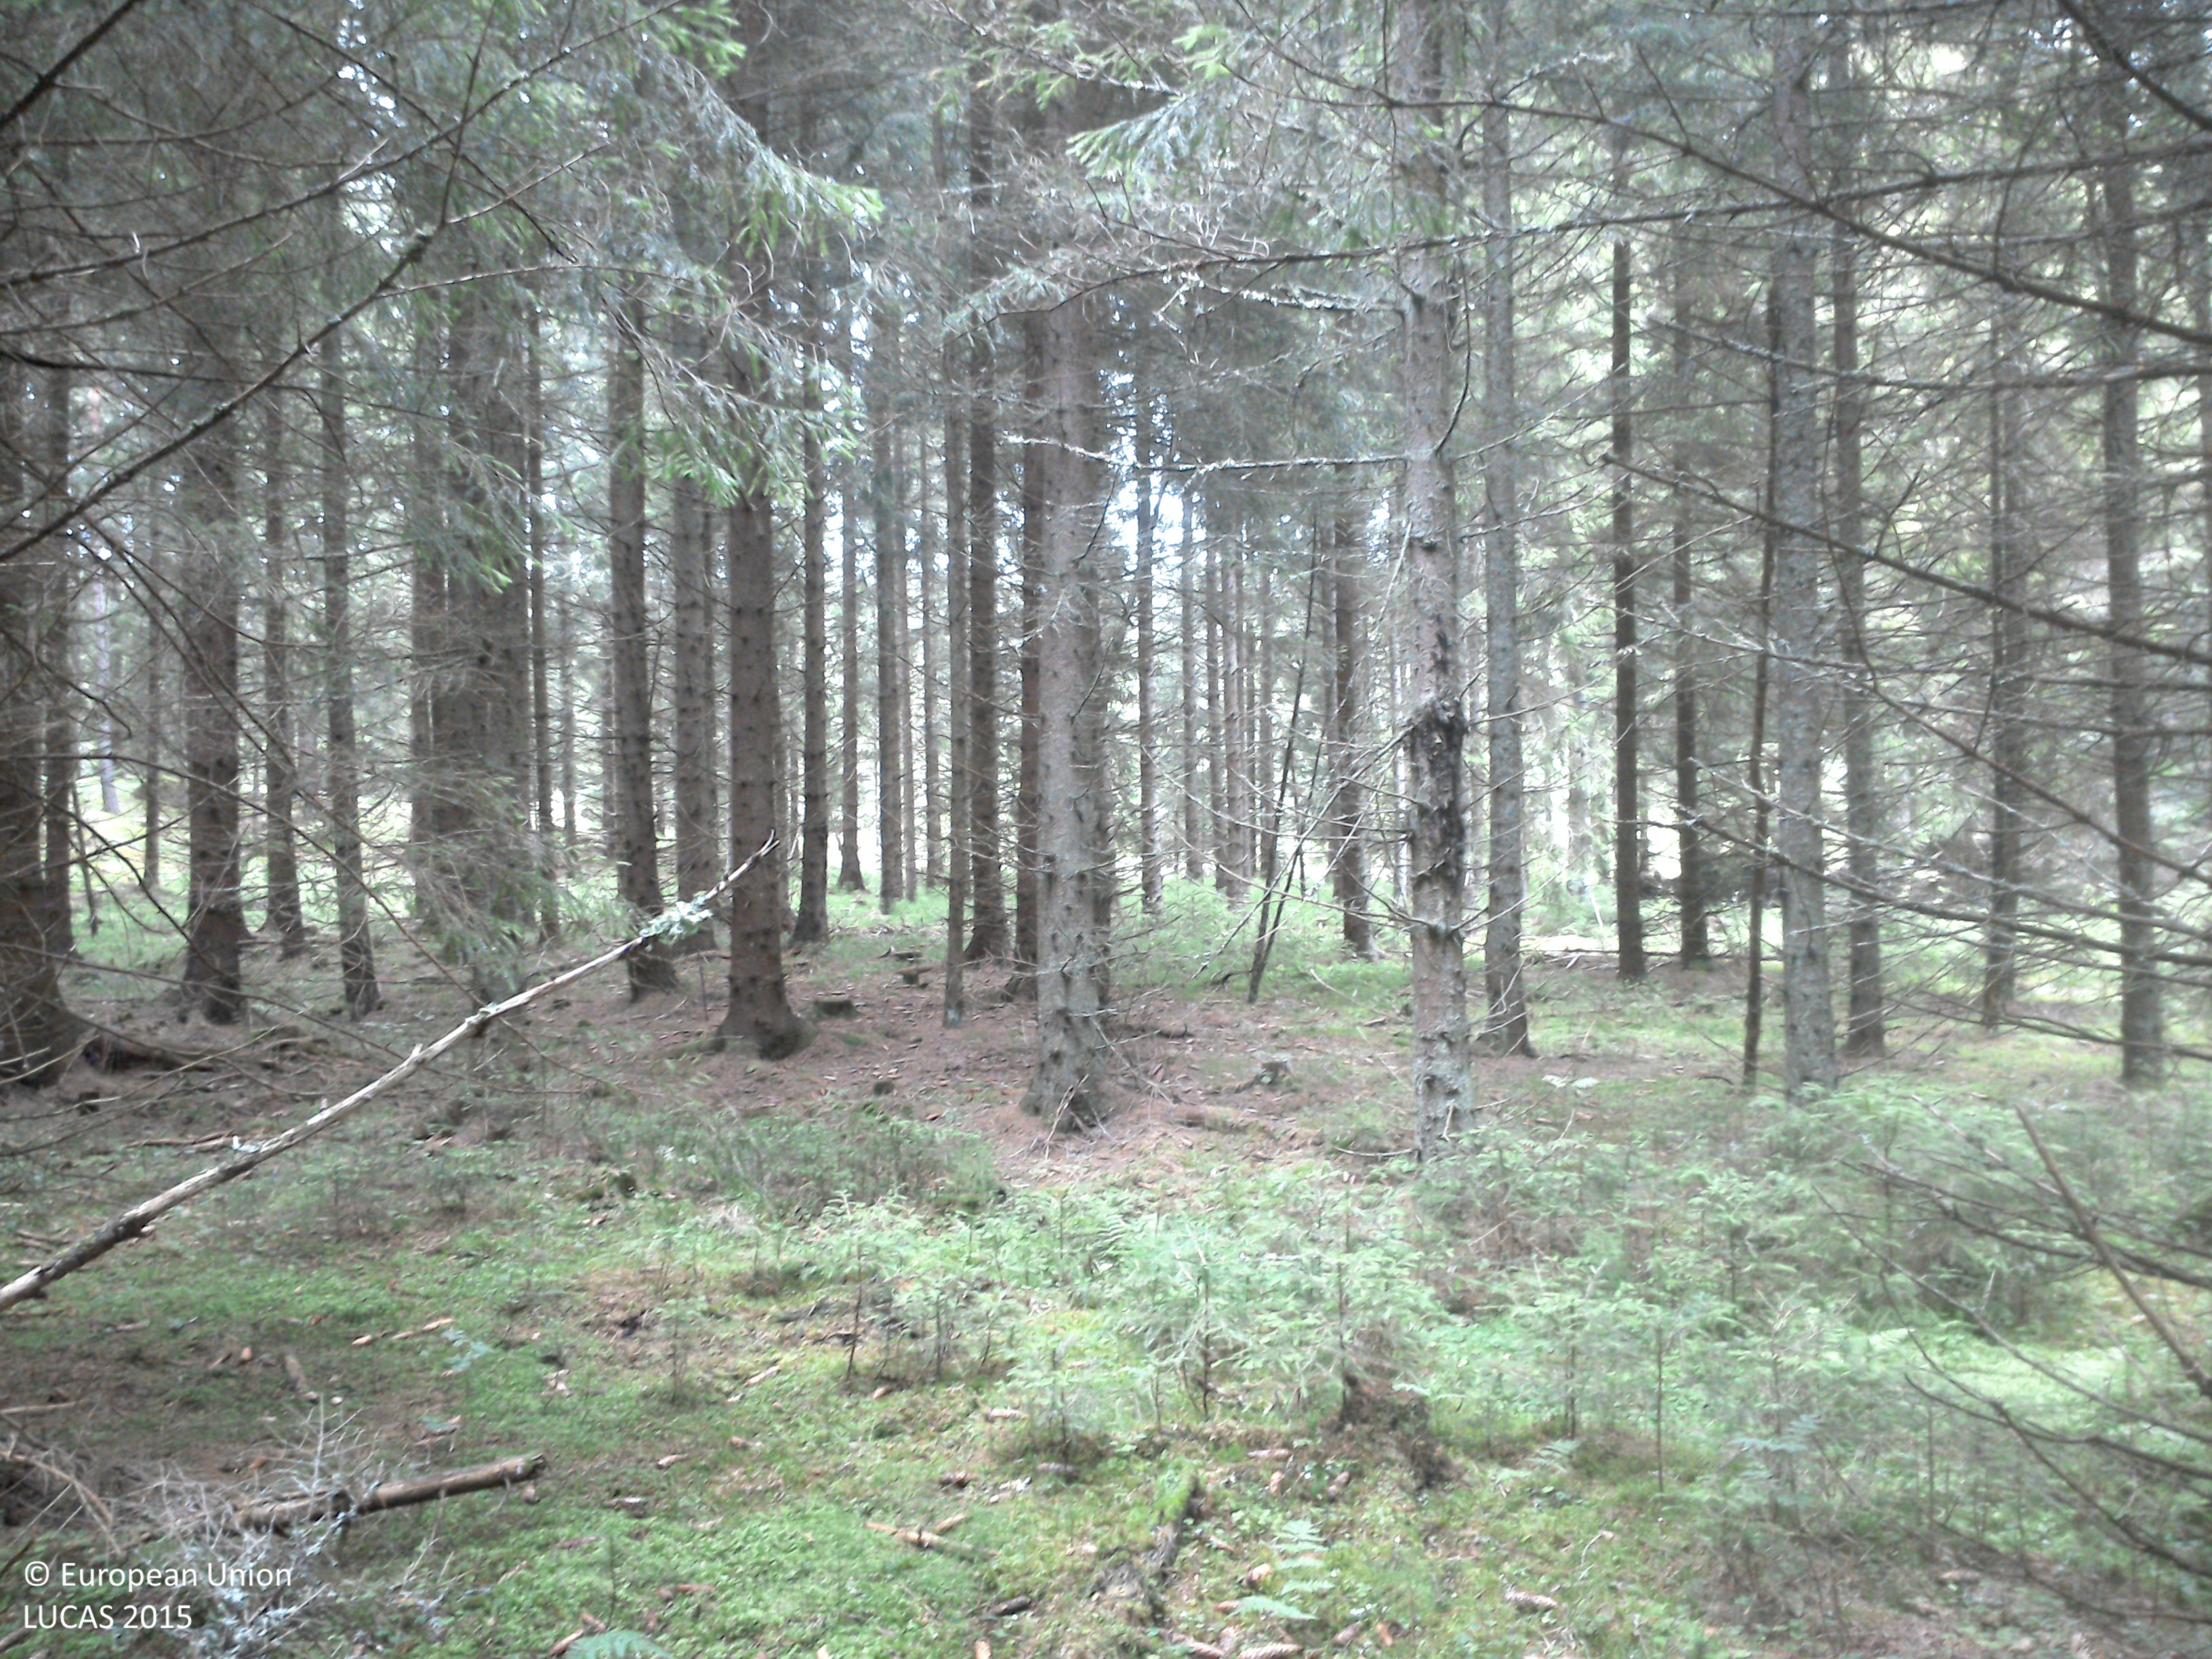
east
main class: Woodland
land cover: Spruce dominated coniferous woodland
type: boreal forest
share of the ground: > 75 %
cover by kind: coniferous forest trees 90 %, lichens and mosses 10 %
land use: Forestry
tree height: > 5 m
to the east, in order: Spruce dominated coniferous woodland; Ditches and canals; Spruce dominated coniferous woodland; Spruce dominated mixed woodland; Electric lines; Spruce dominated mixed woodland; Spruce dominated coniferous woodland; Grassland with sparse tree/shrub cover; Spruce dominated coniferous woodland; Ditches and canals; Spruce dominated coniferous woodland
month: August
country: SE
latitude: 57.8445
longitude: 15.3022
